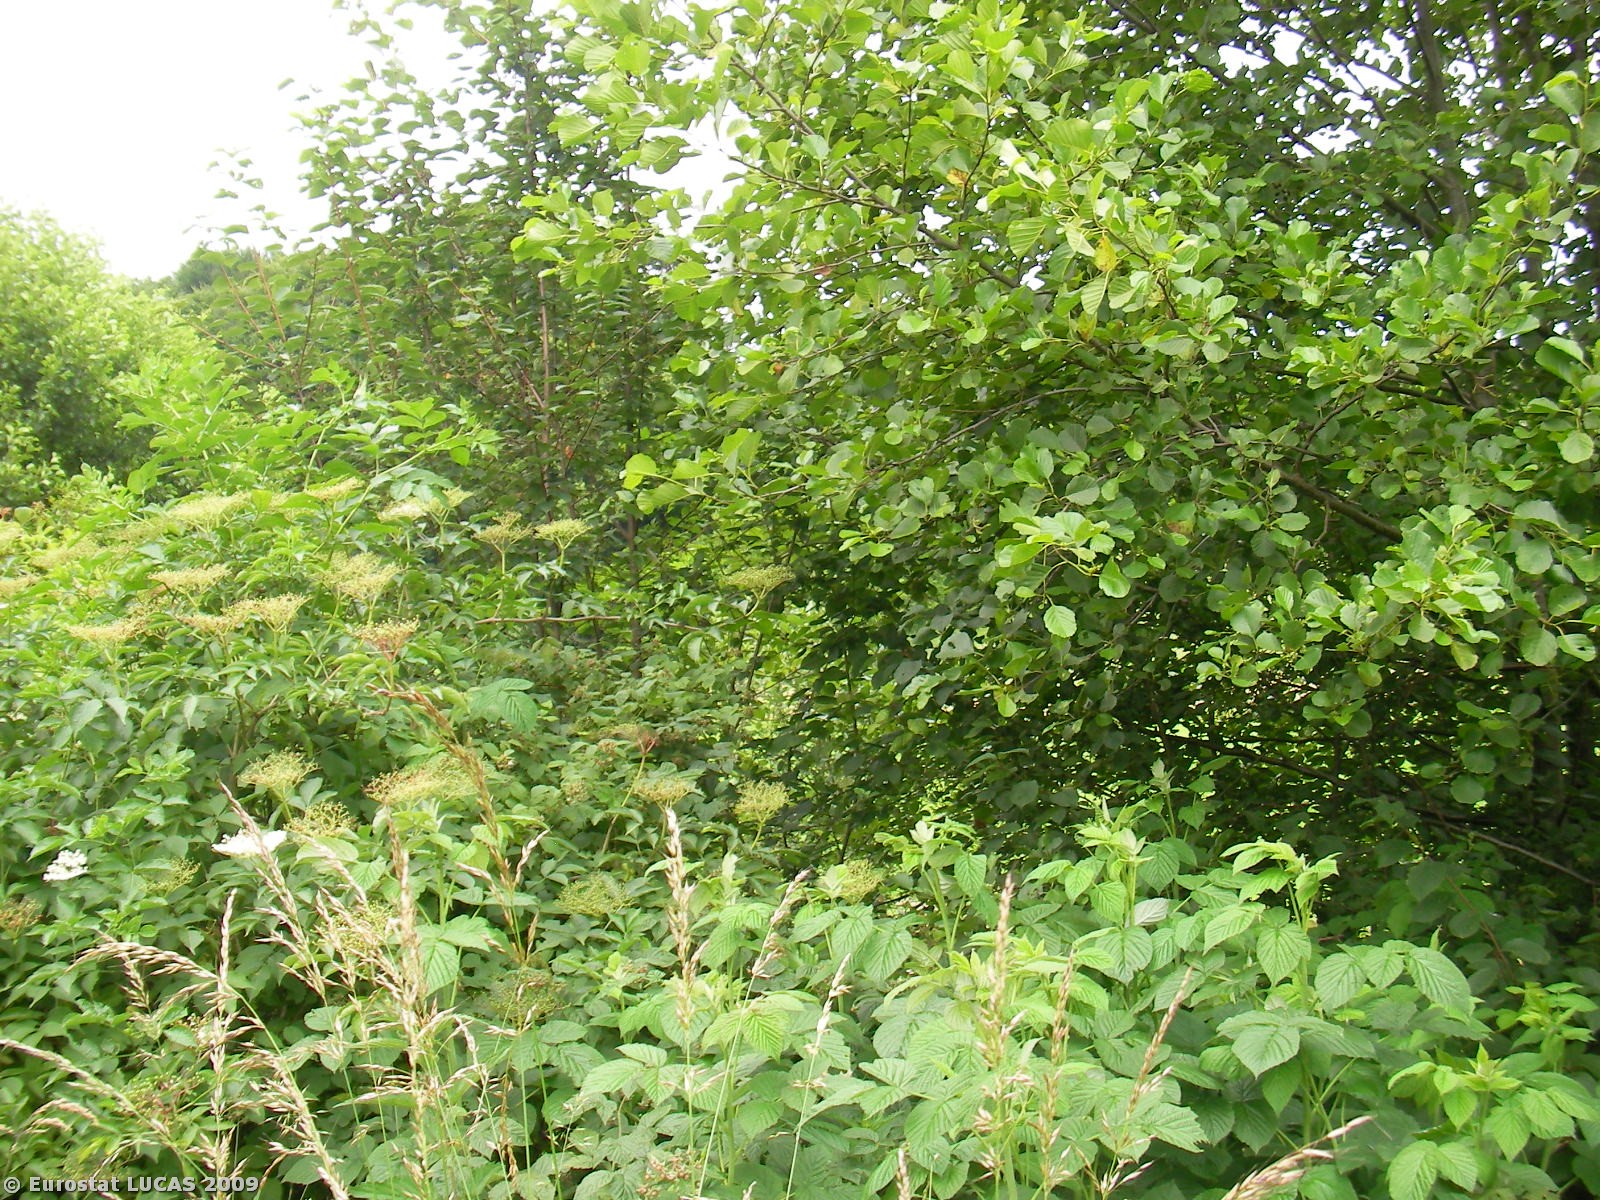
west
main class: Woodland
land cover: Broadleaved woodland
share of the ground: > 75 %
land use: Unused
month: June
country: AT
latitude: 46.9647
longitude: 15.5592
